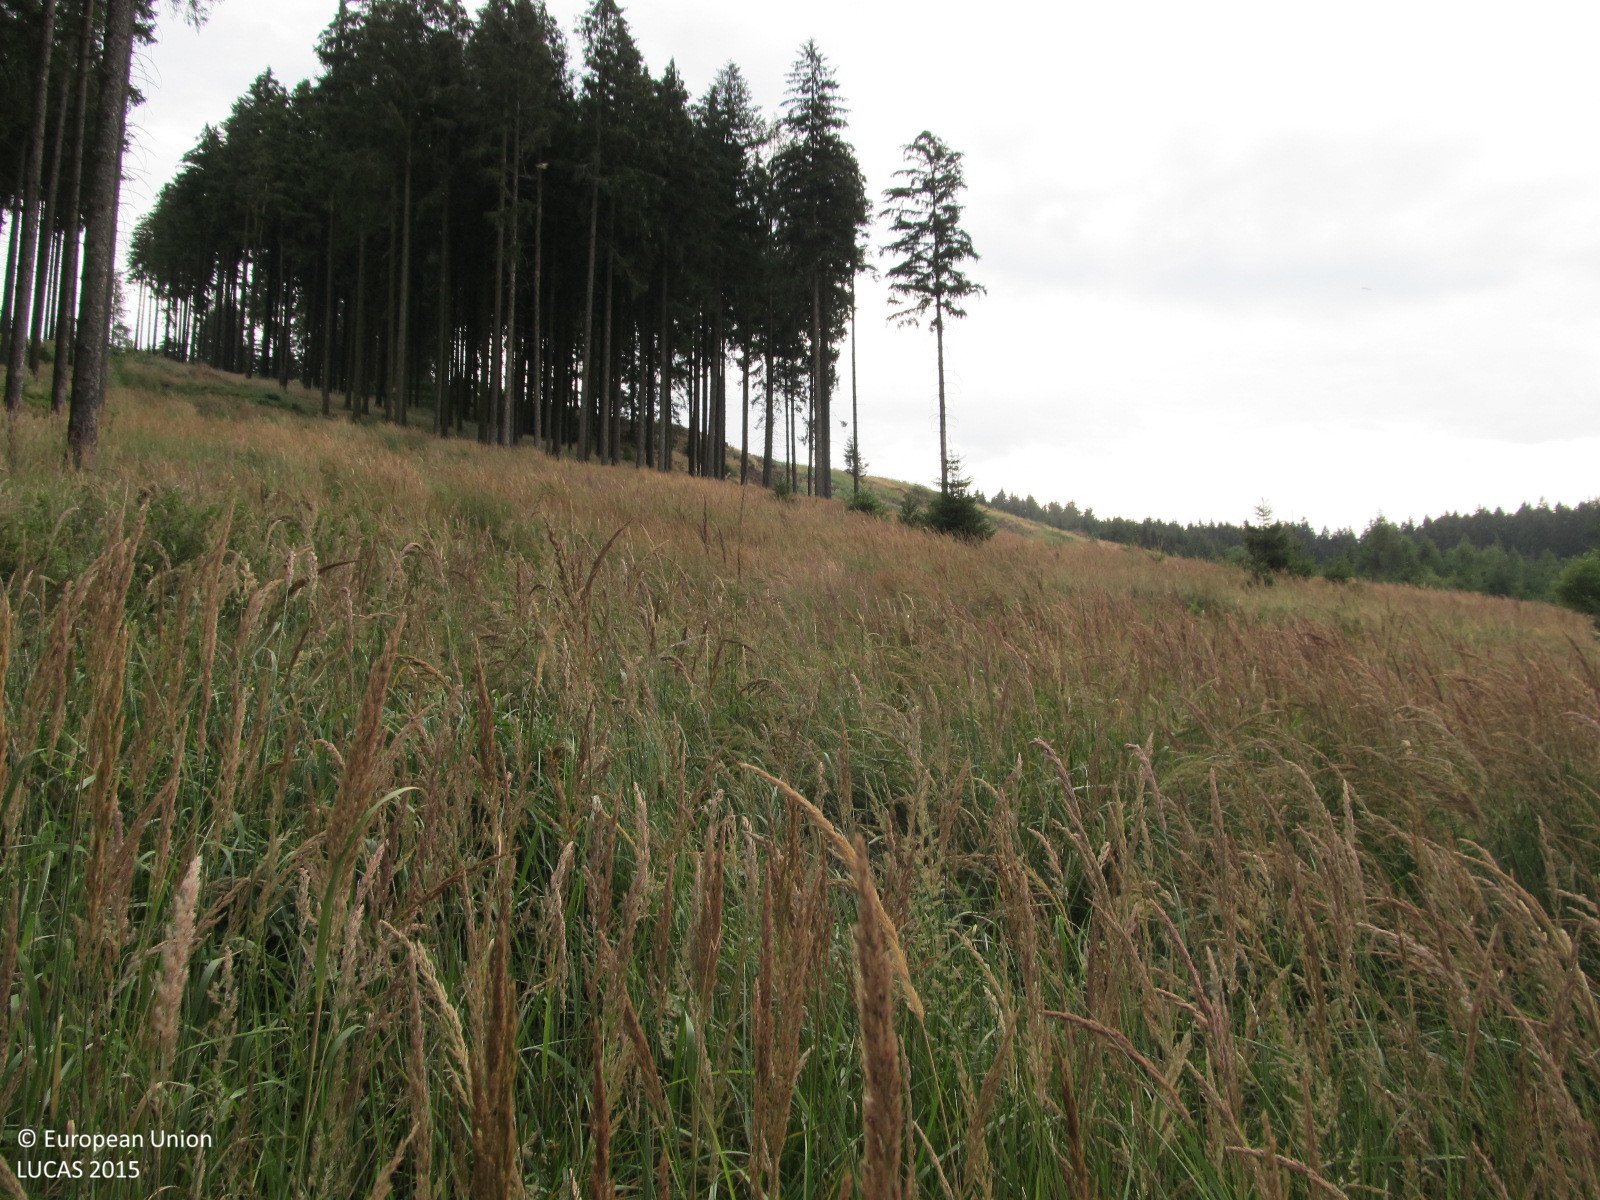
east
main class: Woodland
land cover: Spruce dominated coniferous woodland
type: hemiboreal forest and nemoral coniferous forest and mixed broadleaved-coniferous forest
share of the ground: 50 - 75 %
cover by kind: coniferous forest trees 75 %, herbaceous plants 25 %
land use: Forestry
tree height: > 5 m
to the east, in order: Spruce dominated coniferous woodland; Grassland without tree/shrub cover; Spruce dominated coniferous woodland; Tracks; Spruce dominated coniferous woodland
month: July
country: AT
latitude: 48.2494
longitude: 15.4836
